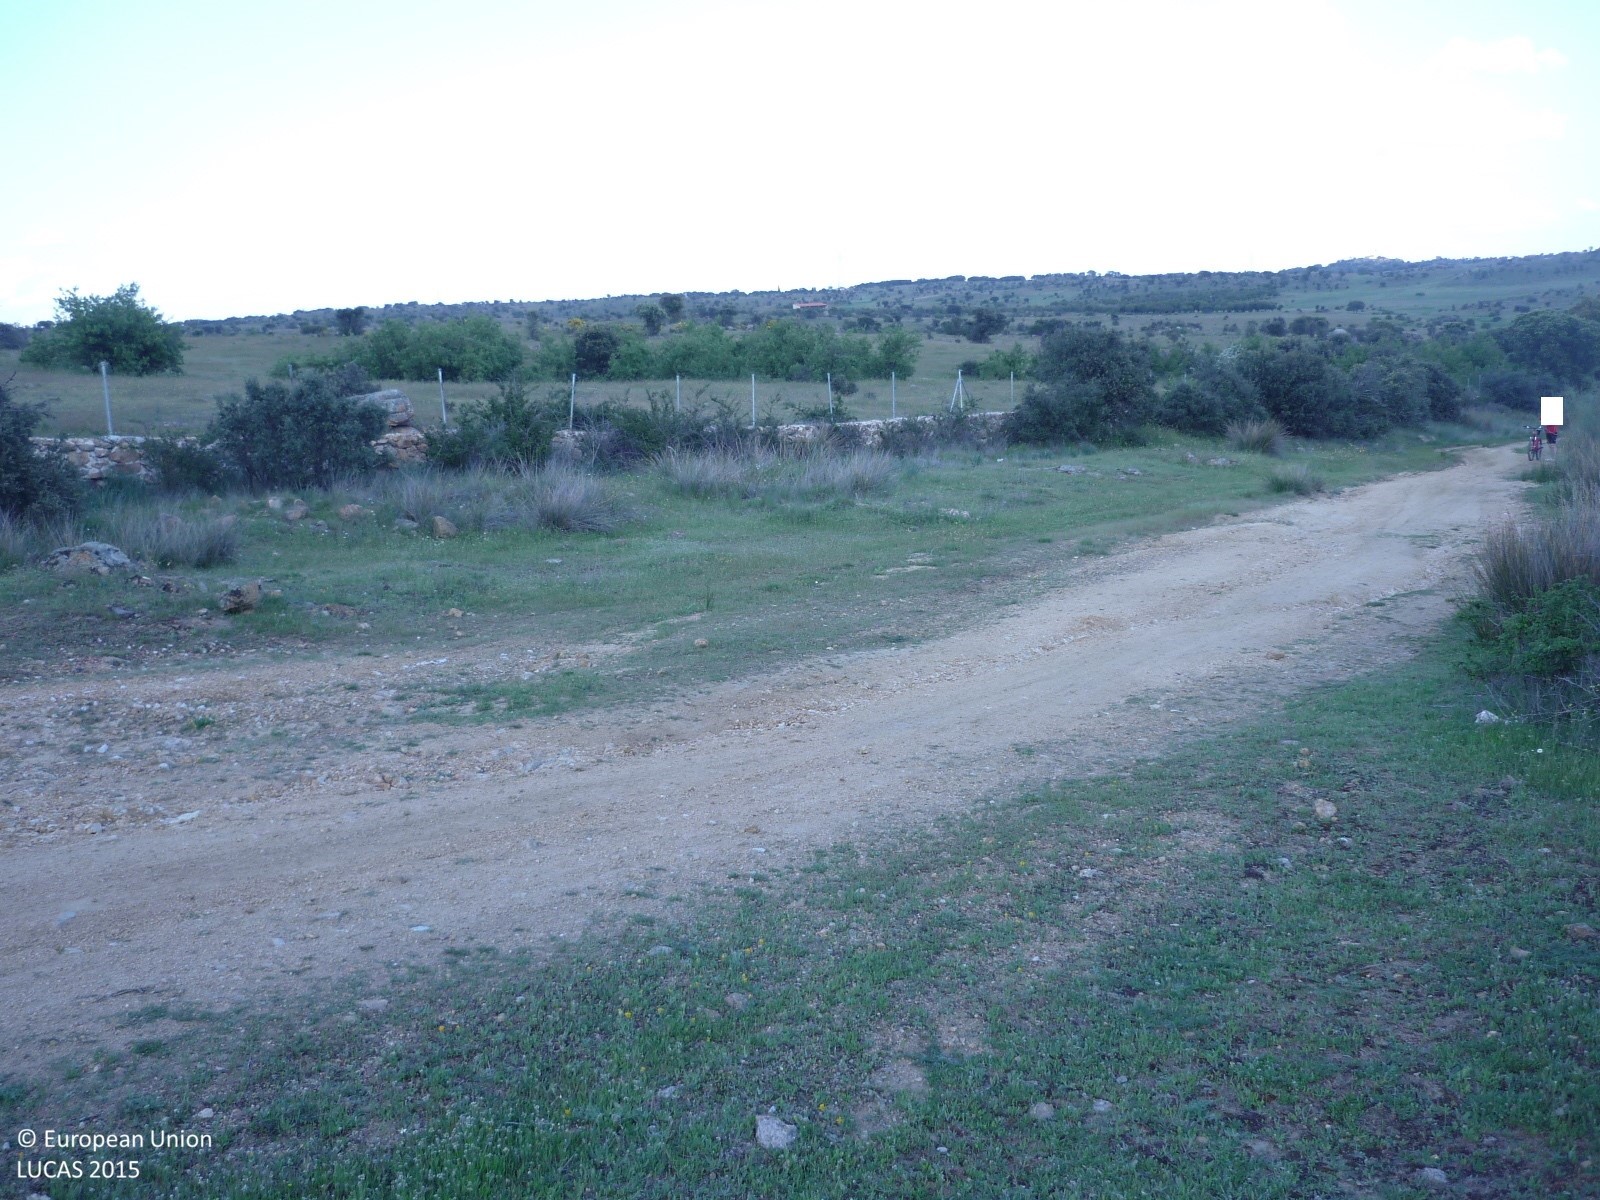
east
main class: Grassland
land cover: Grassland with sparse tree/shrub cover
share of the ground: > 75 %
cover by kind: herbaceous plants 85 %, shrubs 10 %, broadleaved forest trees 5 %
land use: Agriculture (excluding fallow land and kitchen gardens)
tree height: > 5 m
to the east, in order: Grassland with sparse tree/shrub cover; Tracks; Grassland with sparse tree/shrub cover; Dry stone walls; Grassland without tree/shrub cover; Grassland with sparse tree/shrub cover; Grassland without tree/shrub cover
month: April
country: ES
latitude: 40.7794
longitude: -3.6081
